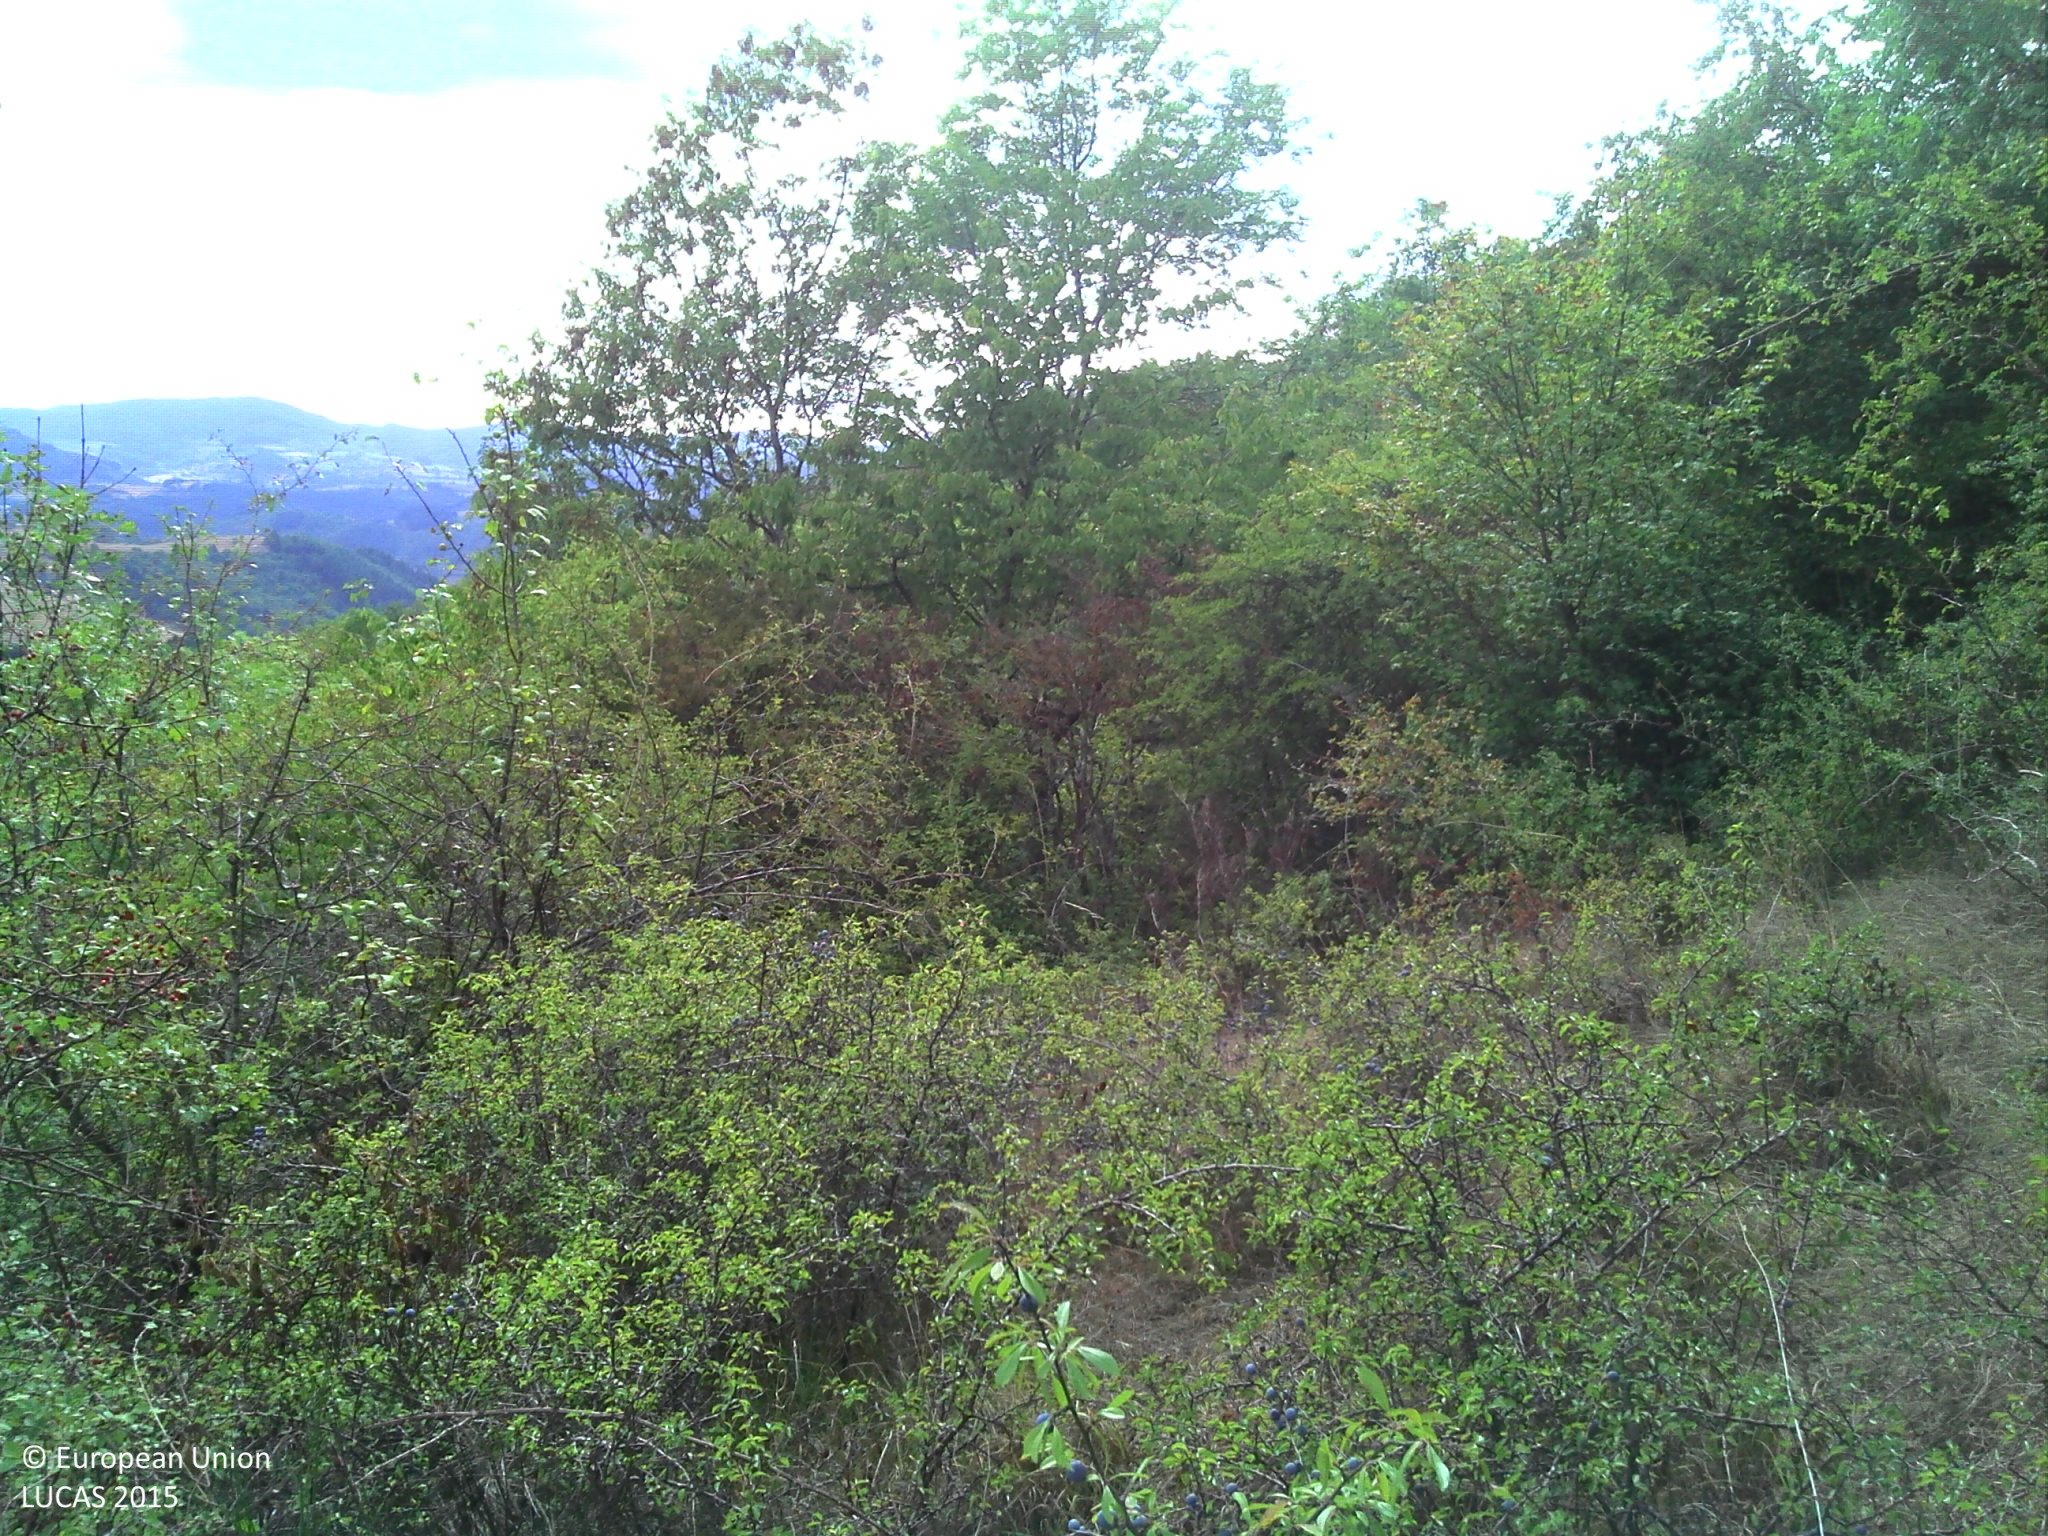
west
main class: Shrubland
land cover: Shrubland with sparse tree cover
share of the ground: > 75 %
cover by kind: shrubs 60 %, herbaceous plants 30 %, broadleaved forest trees 5 %, lichens and mosses 5 %
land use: Semi-natural and natural areas not in use
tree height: < 5 m
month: August
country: FR
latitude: 46.0311
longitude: 4.5375
